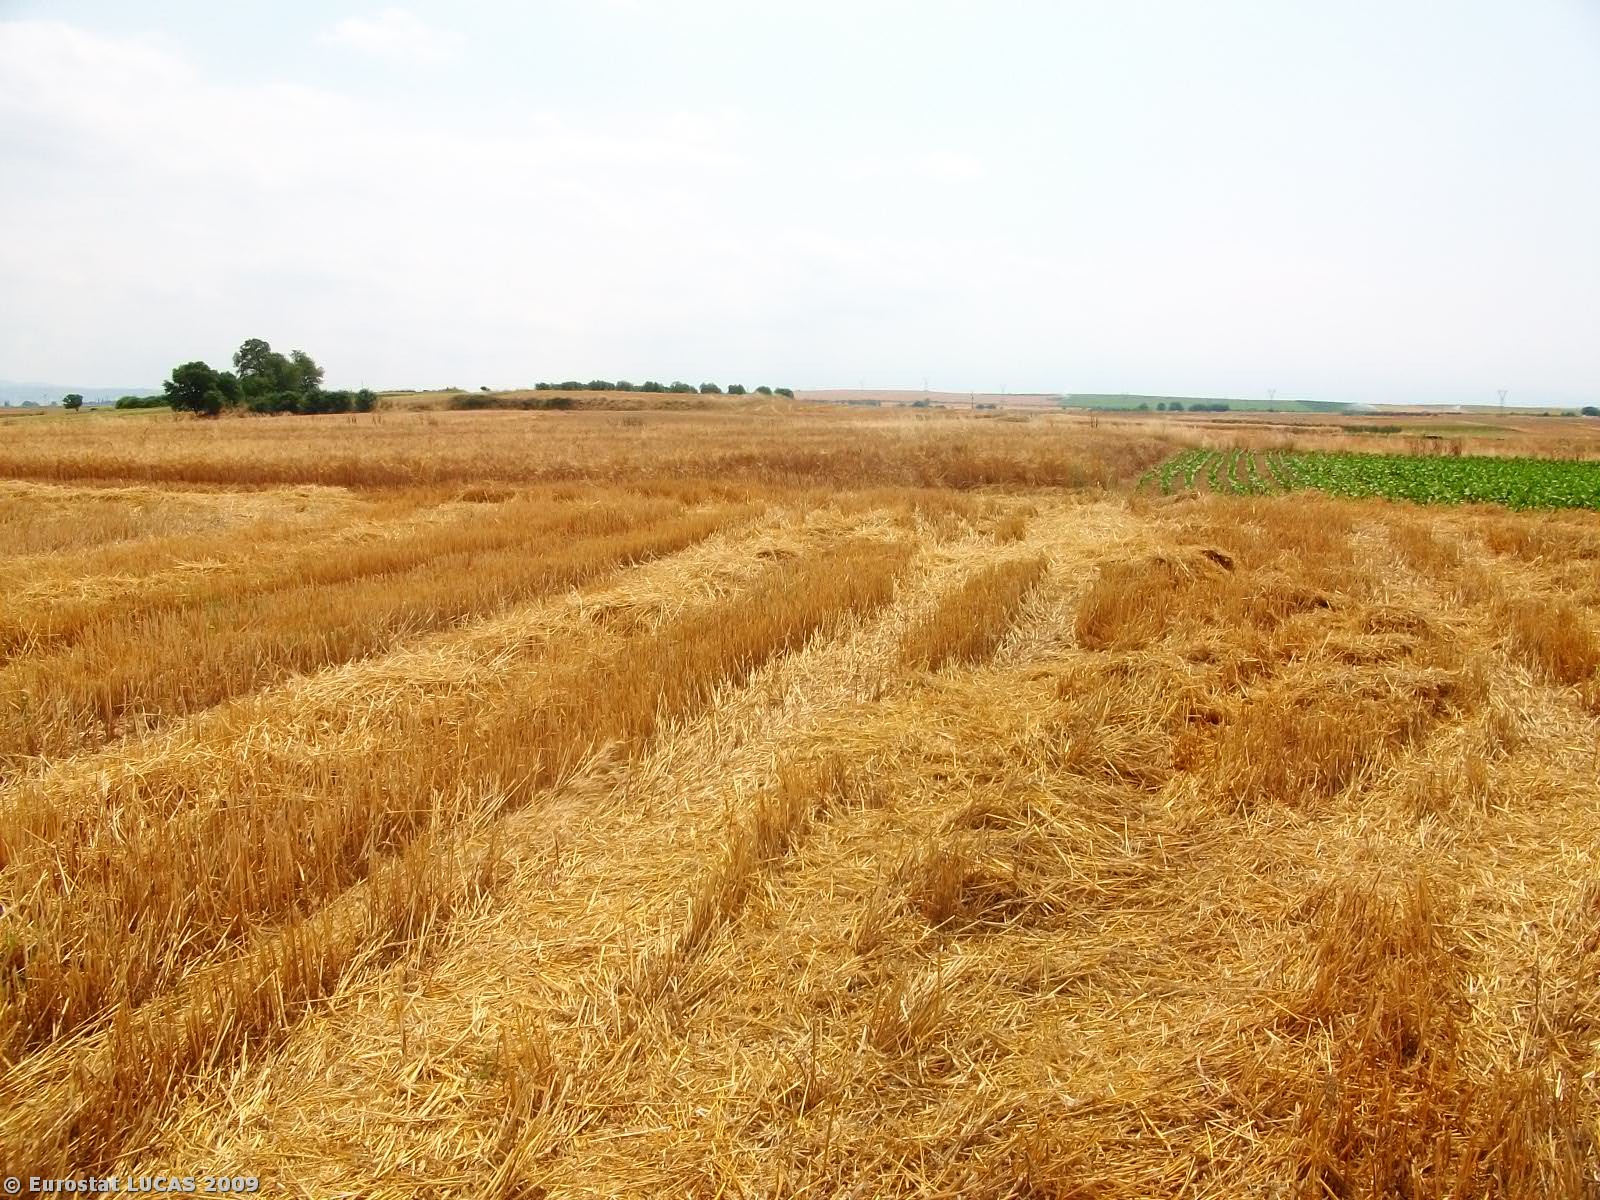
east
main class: Cropland
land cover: Durum wheat
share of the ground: > 75 %
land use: Agriculture (excluding fallow land and kitchen gardens)
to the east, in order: Durum wheat; Grassland without tree/shrub cover; Paved roads, cycling and walking lanes; Grass margins; Durum wheat; Shruby margins; Durum wheat
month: June
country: GR
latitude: 41.0490
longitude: 23.6433
